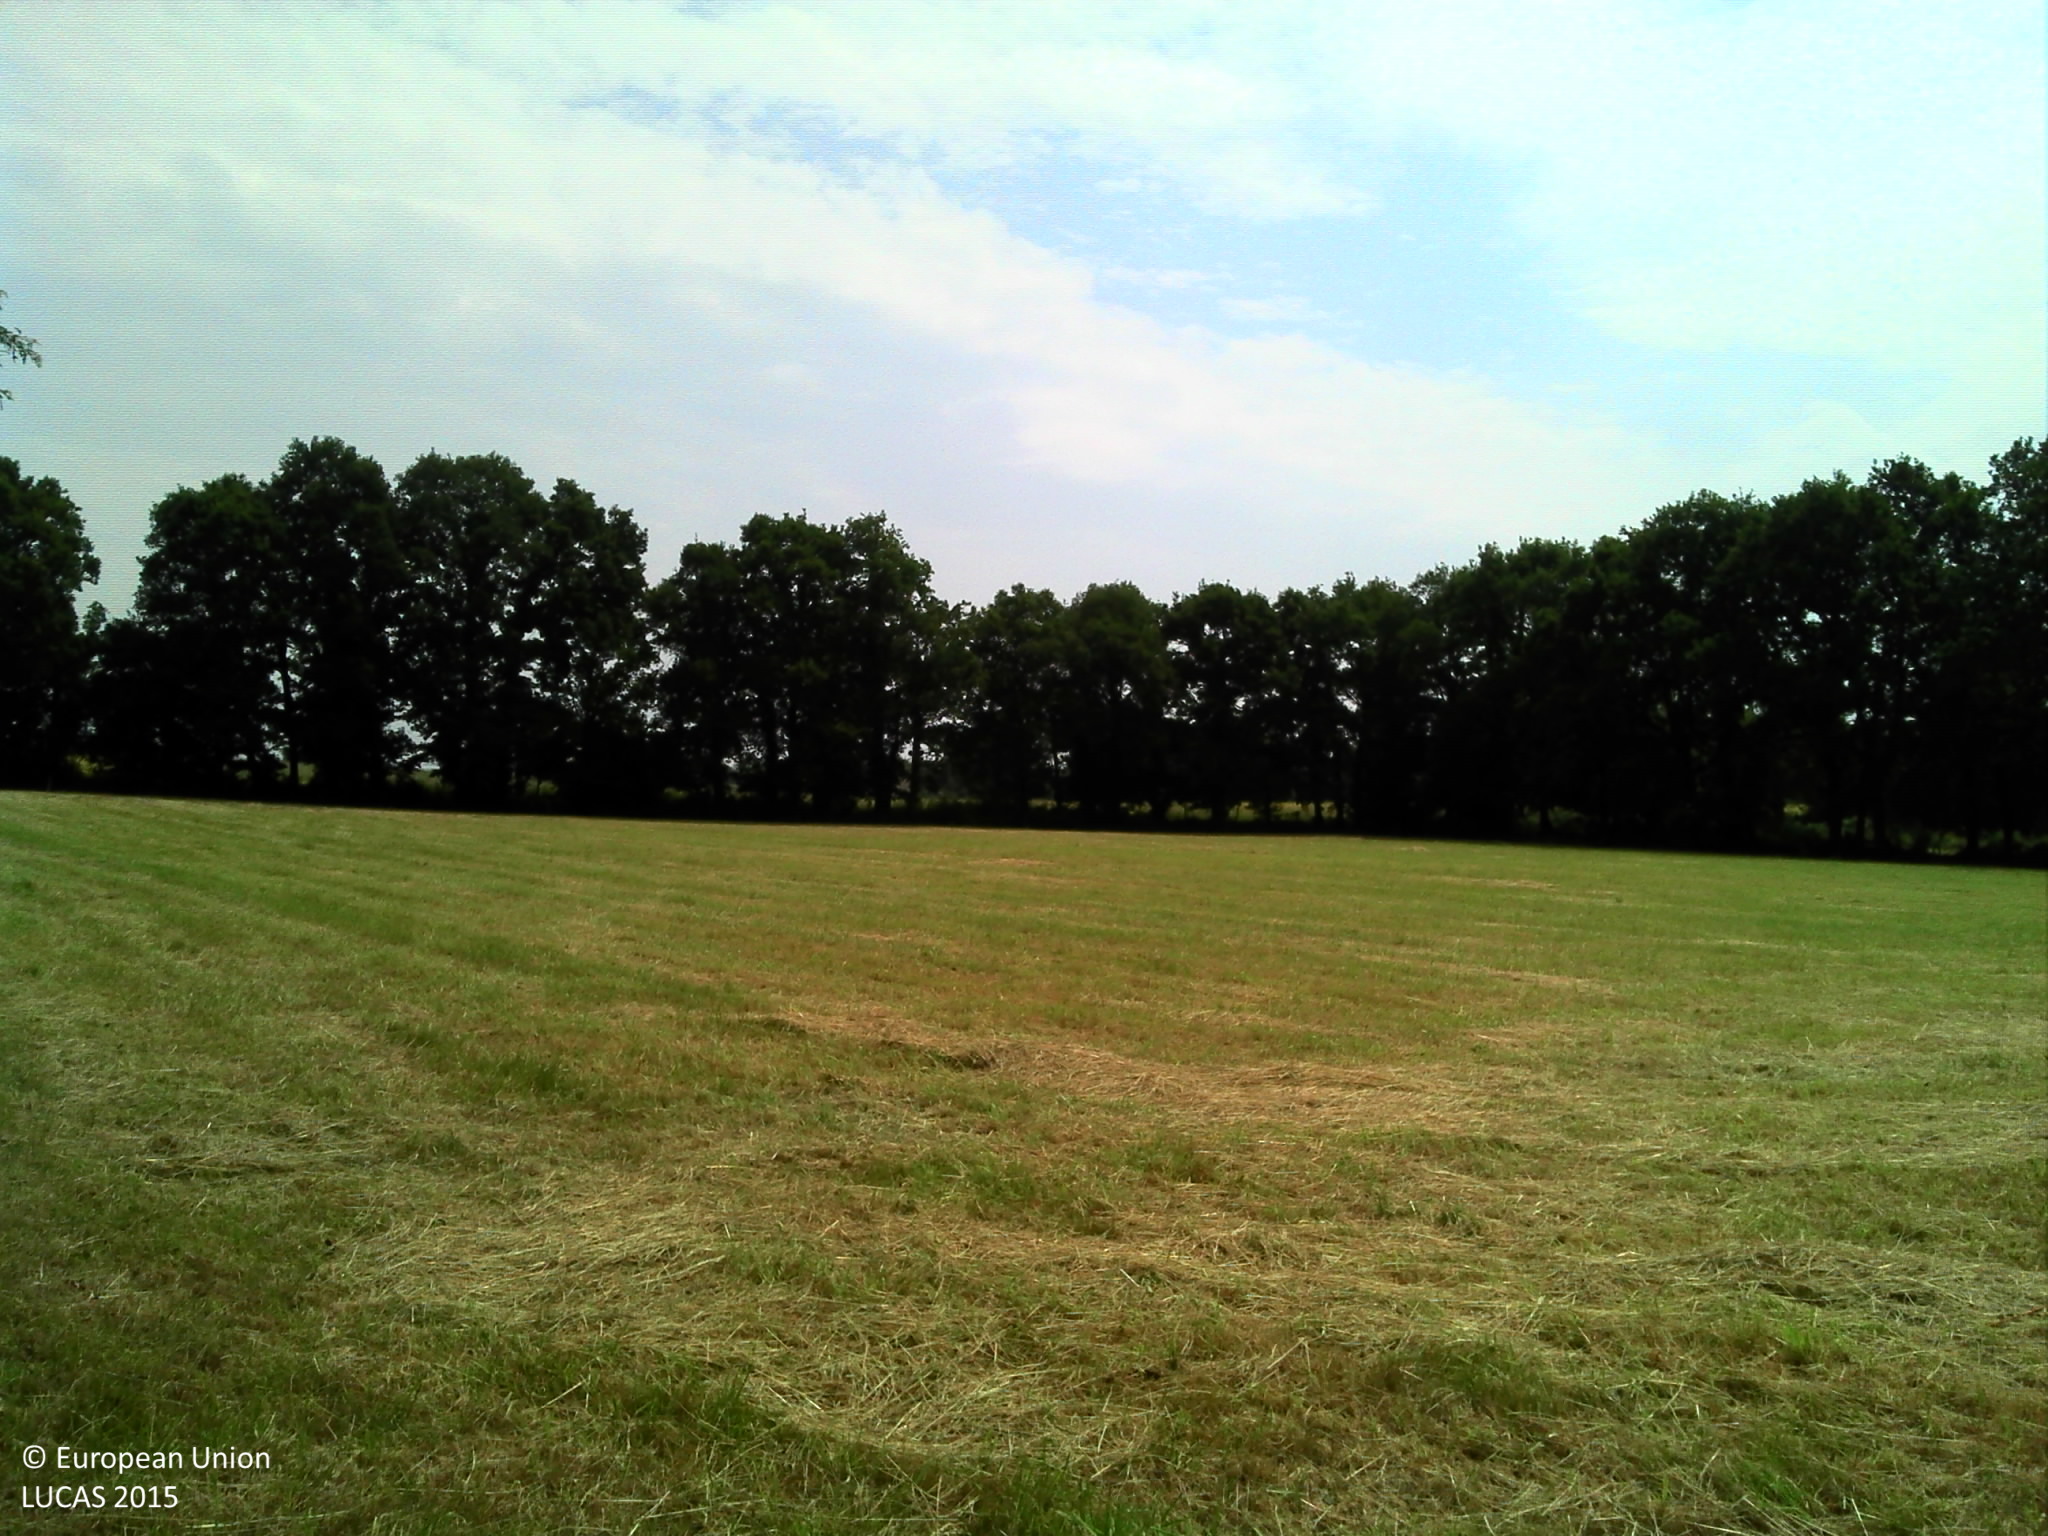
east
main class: Grassland
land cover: Grassland without tree/shrub cover
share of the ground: > 75 %
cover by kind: herbaceous plants 100 %
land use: Agriculture (excluding fallow land and kitchen gardens)
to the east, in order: Abandoned hedges; Grassland without tree/shrub cover; Fences; Abandoned hedges; Tracks; Abandoned hedges; Barley
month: June
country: FR
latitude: 48.1355
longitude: -2.1079
